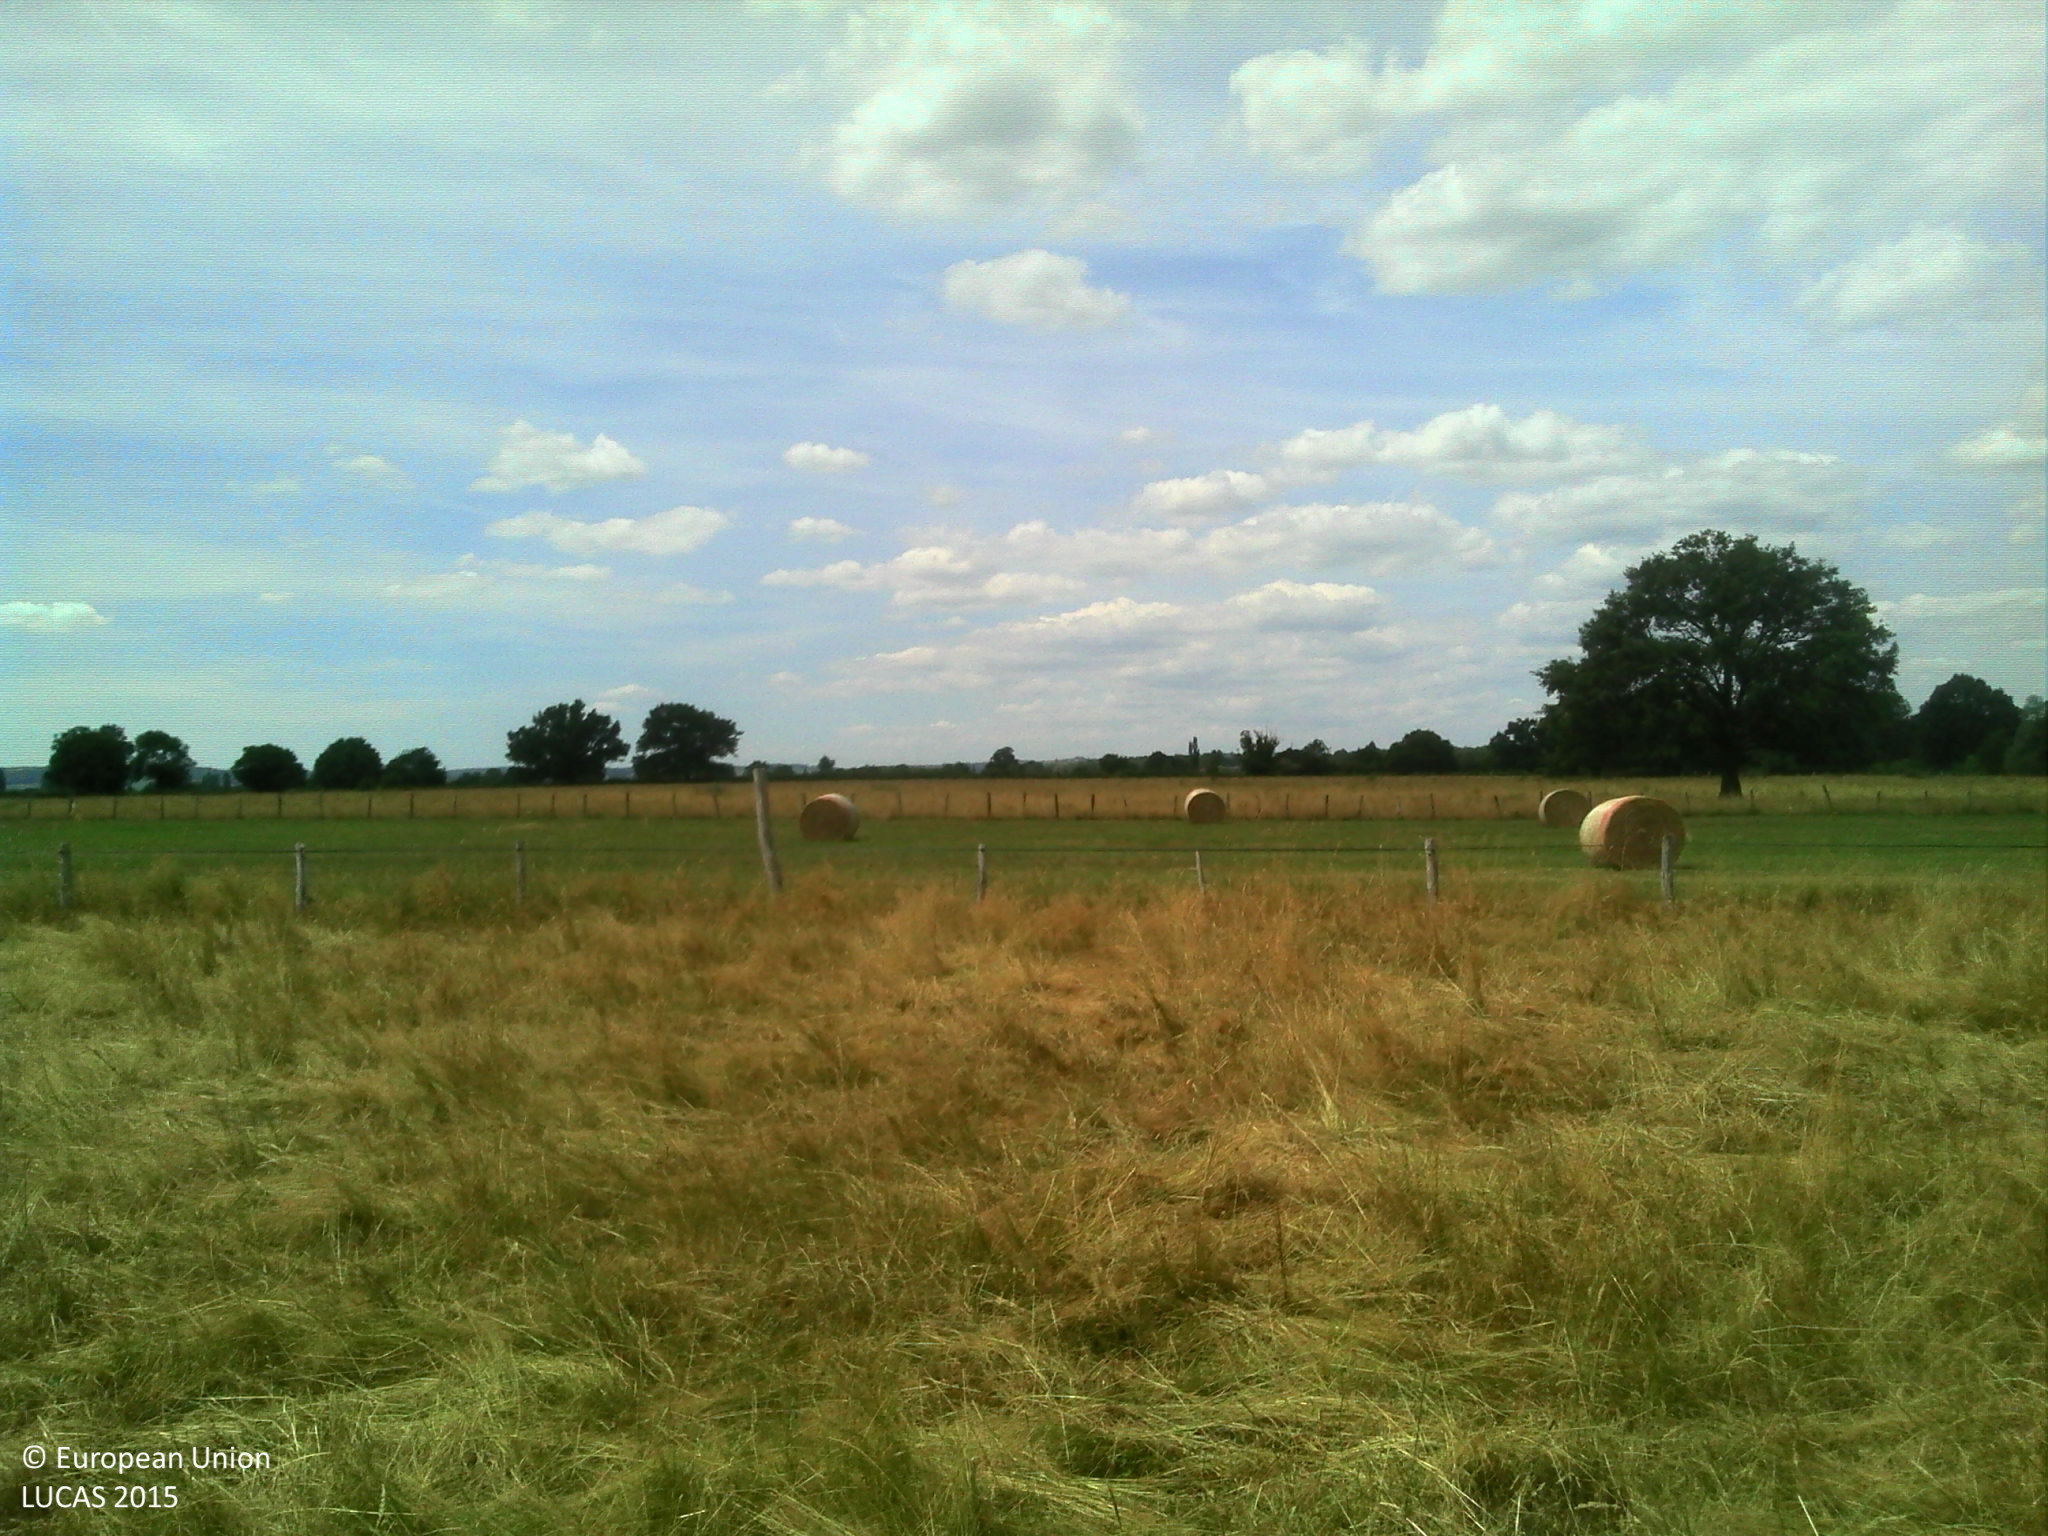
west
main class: Grassland
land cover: Grassland without tree/shrub cover
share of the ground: > 75 %
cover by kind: herbaceous plants 100 %
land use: Agriculture (excluding fallow land and kitchen gardens)
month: June
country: FR
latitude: 46.6560
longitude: 4.7613
